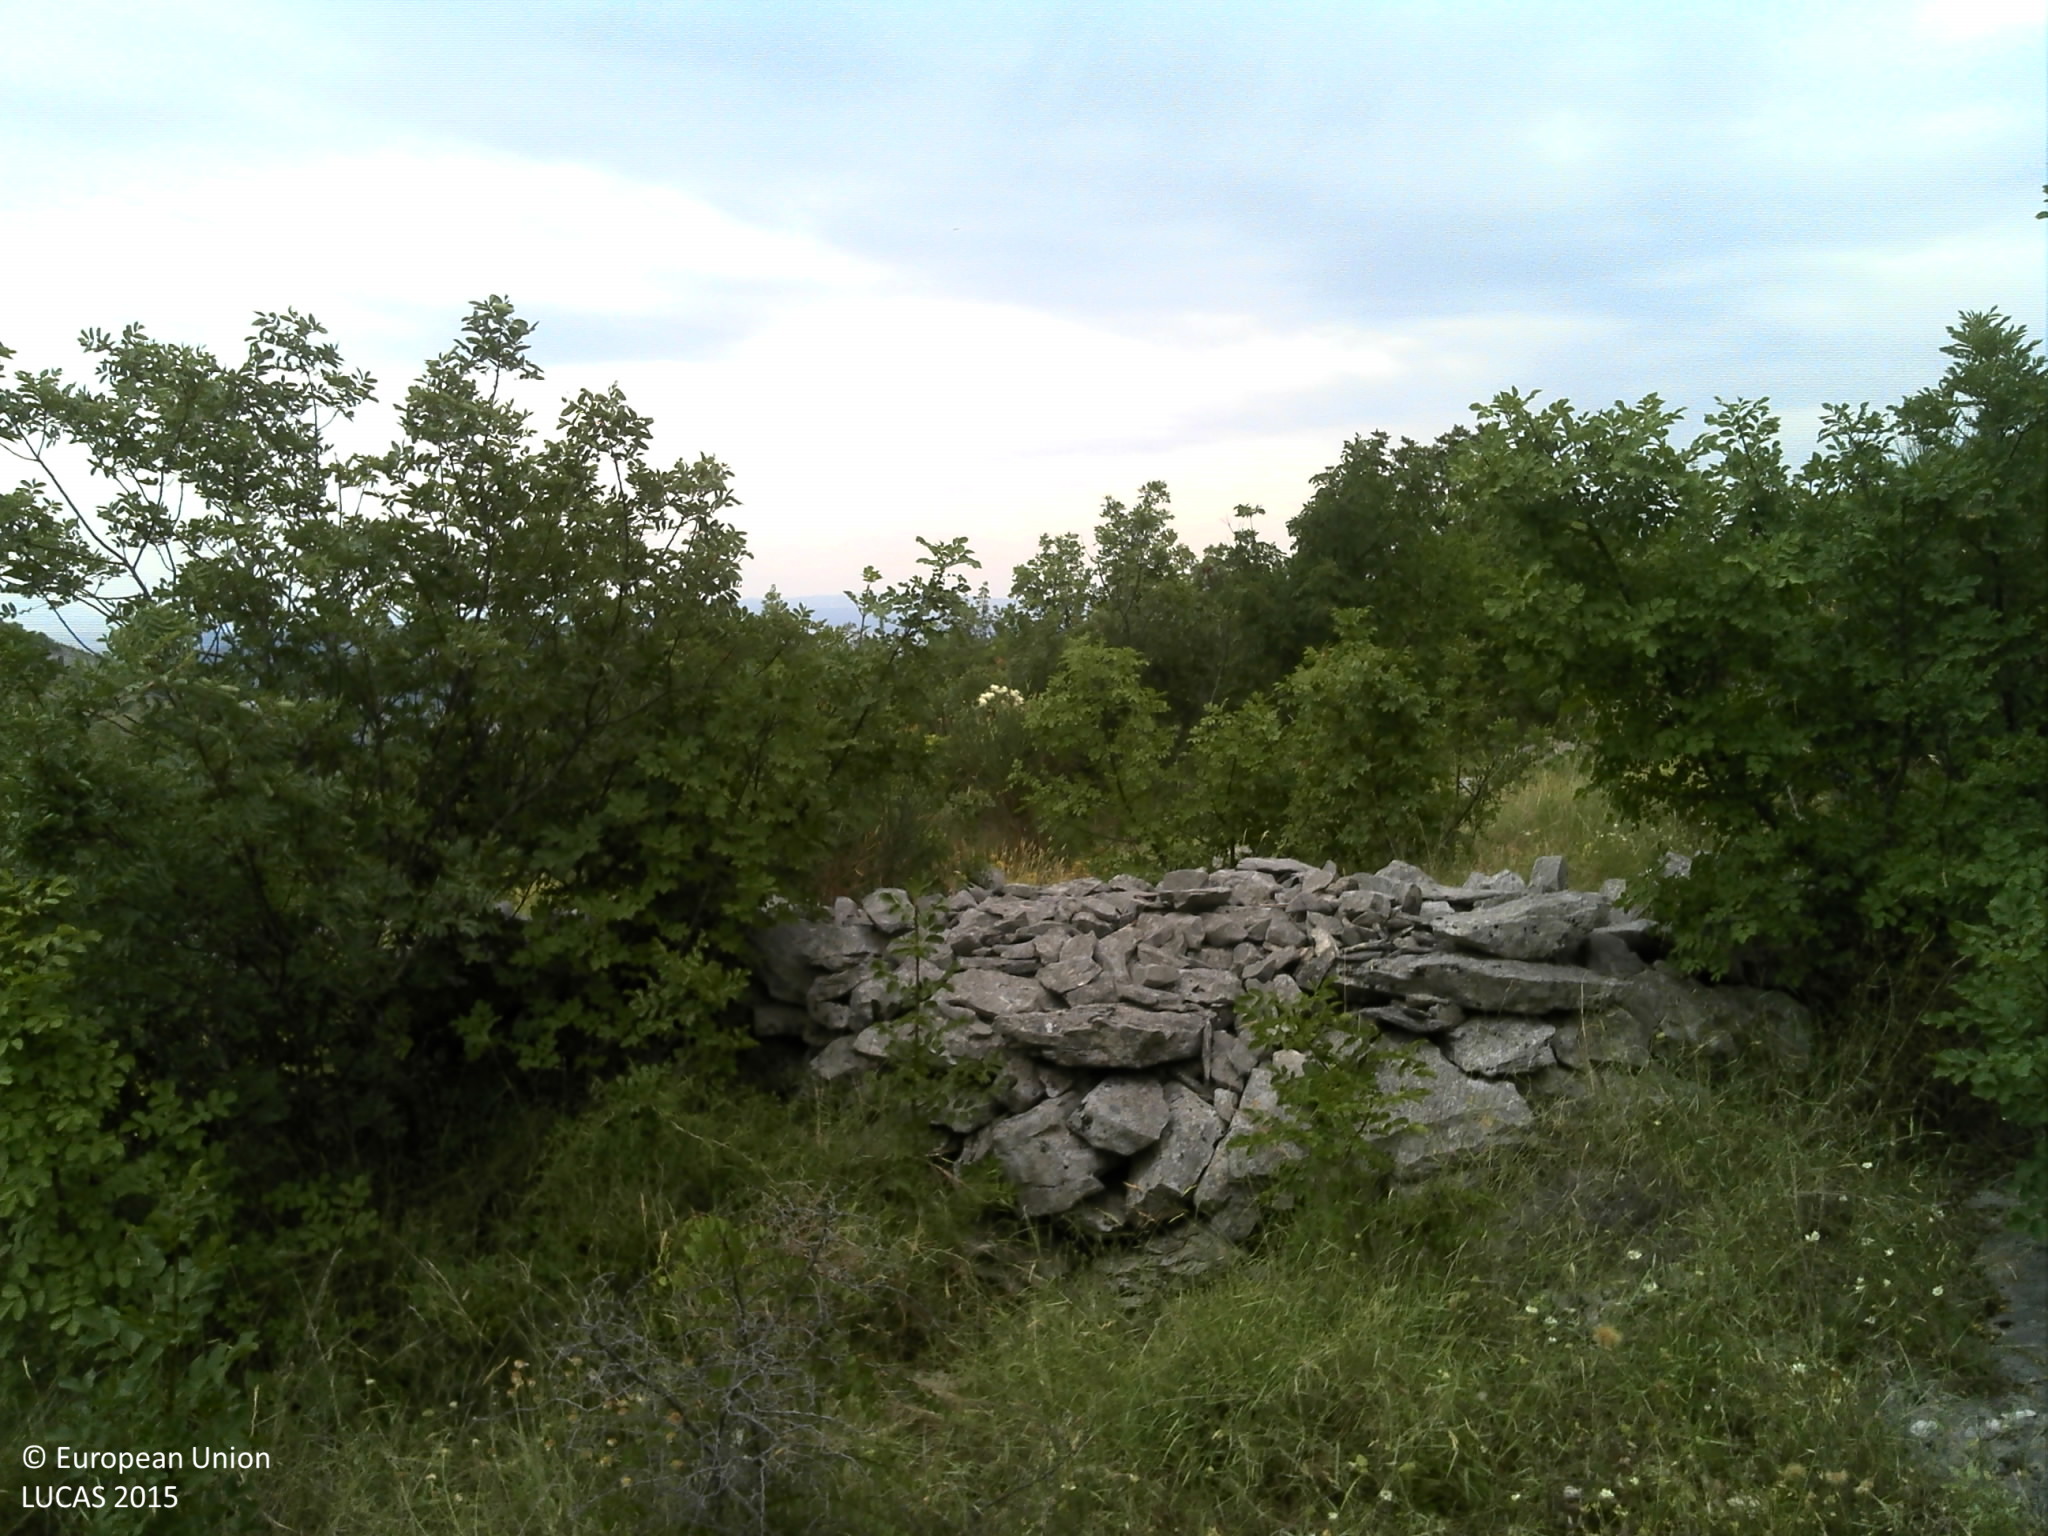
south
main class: Shrubland
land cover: Shrubland with sparse tree cover
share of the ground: 25 - 50 %
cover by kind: shrubs 40 %, herbaceous plants 25 %, consolidated bare surface 15 %, unconsolidated bare surface 15 %, broadleaved forest trees 5 %
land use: Semi-natural and natural areas not in use
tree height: < 5 m
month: June
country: HR
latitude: 43.5311
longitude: 16.2146
